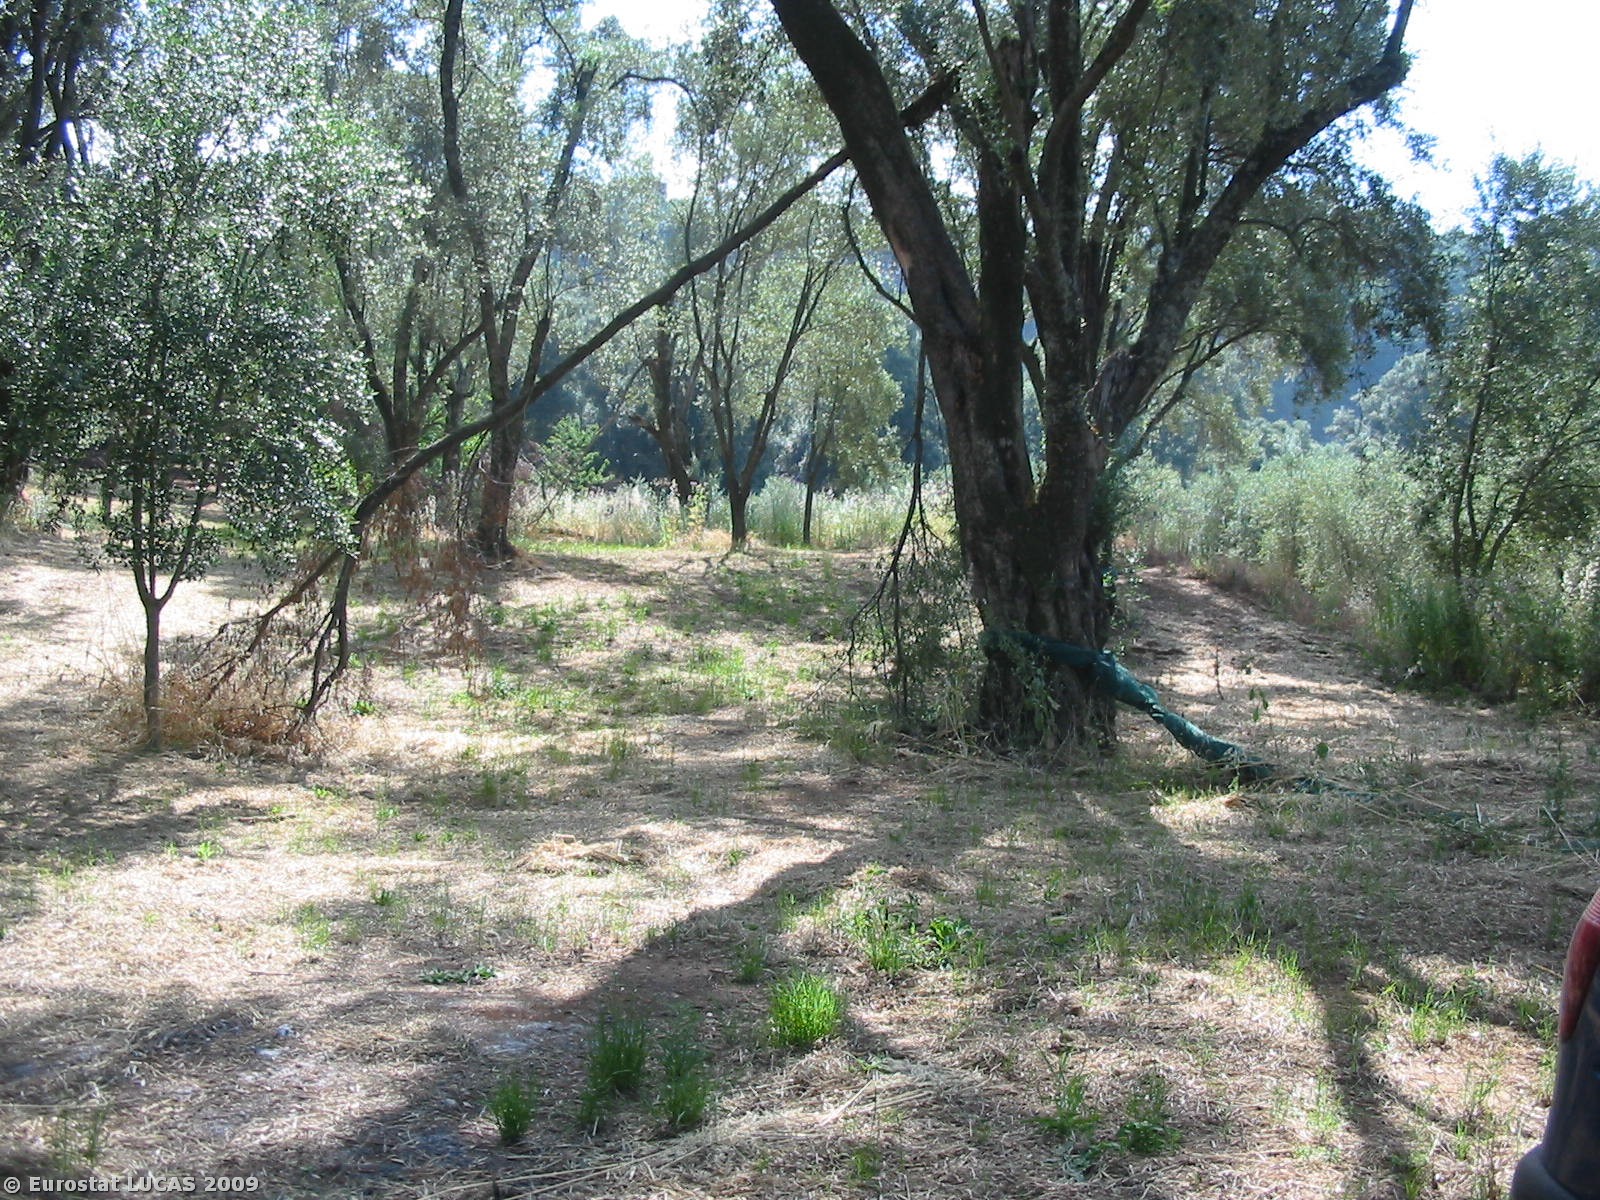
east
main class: Cropland
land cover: Olive groves
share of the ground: 50 - 75 %
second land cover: Bare land
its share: > 75 %
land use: Agriculture (excluding fallow land and kitchen gardens)
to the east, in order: Olive groves; Bare land
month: June
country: IT
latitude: 38.2890
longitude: 15.9436
